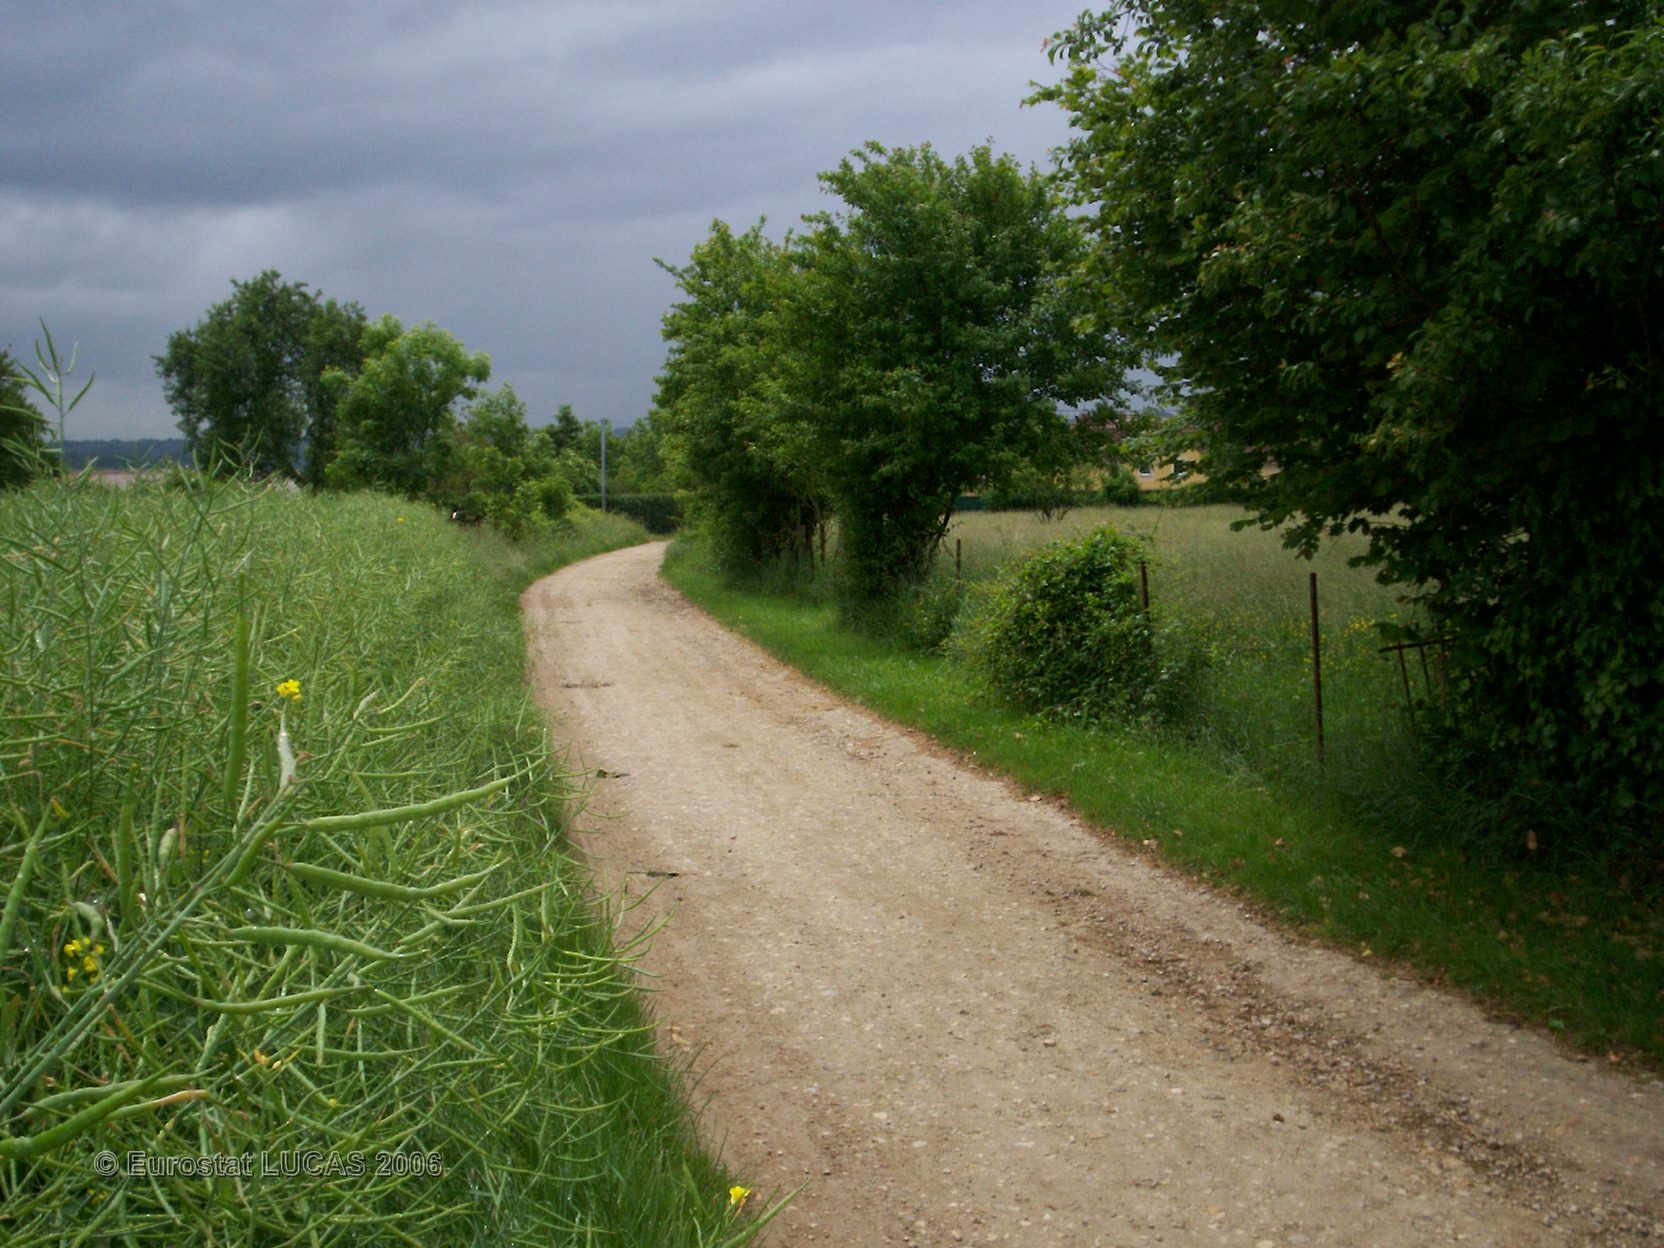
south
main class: Cropland
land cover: Rape and turnip rape
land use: Agriculture (excluding fallow land and kitchen gardens)
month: May
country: FR
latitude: 48.8948
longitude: 2.8568
